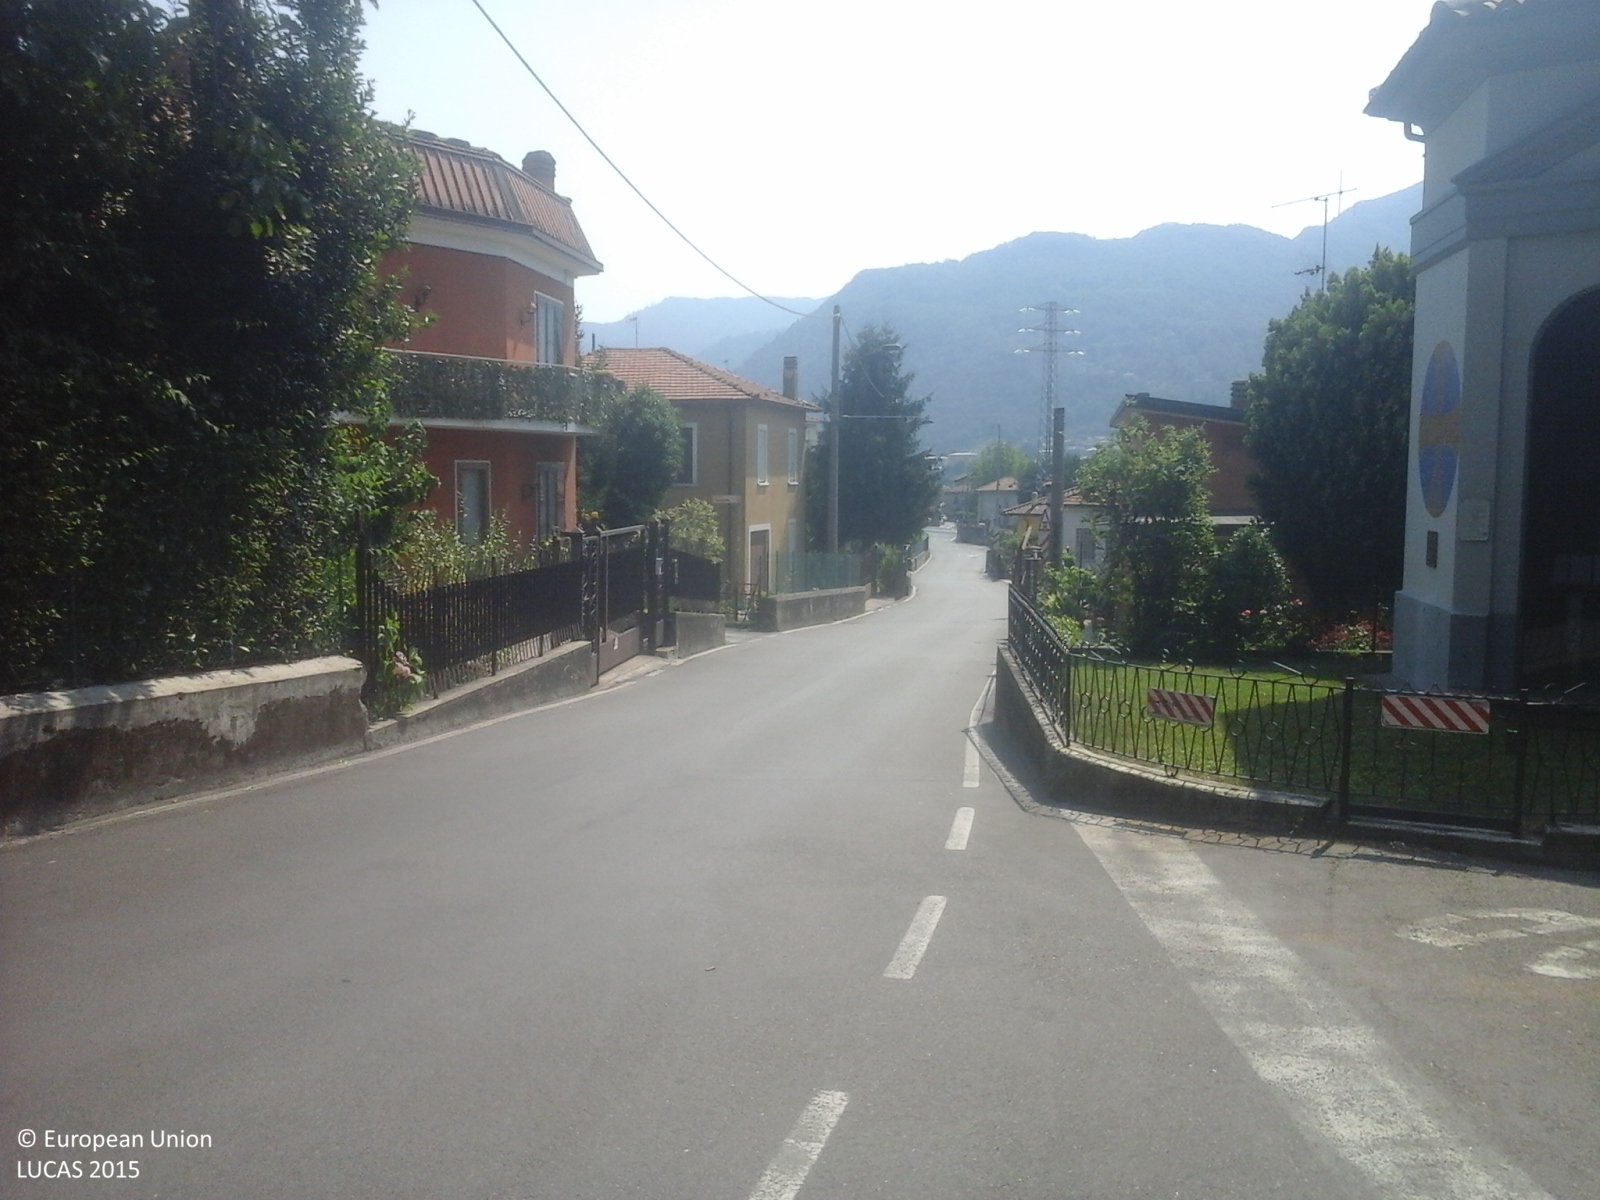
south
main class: Woodland
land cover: Broadleaved woodland
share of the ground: > 75 %
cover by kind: broadleaved forest trees 95 %, shrubs 5 %
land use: Residential
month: July
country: IT
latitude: 45.8092
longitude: 9.4218
